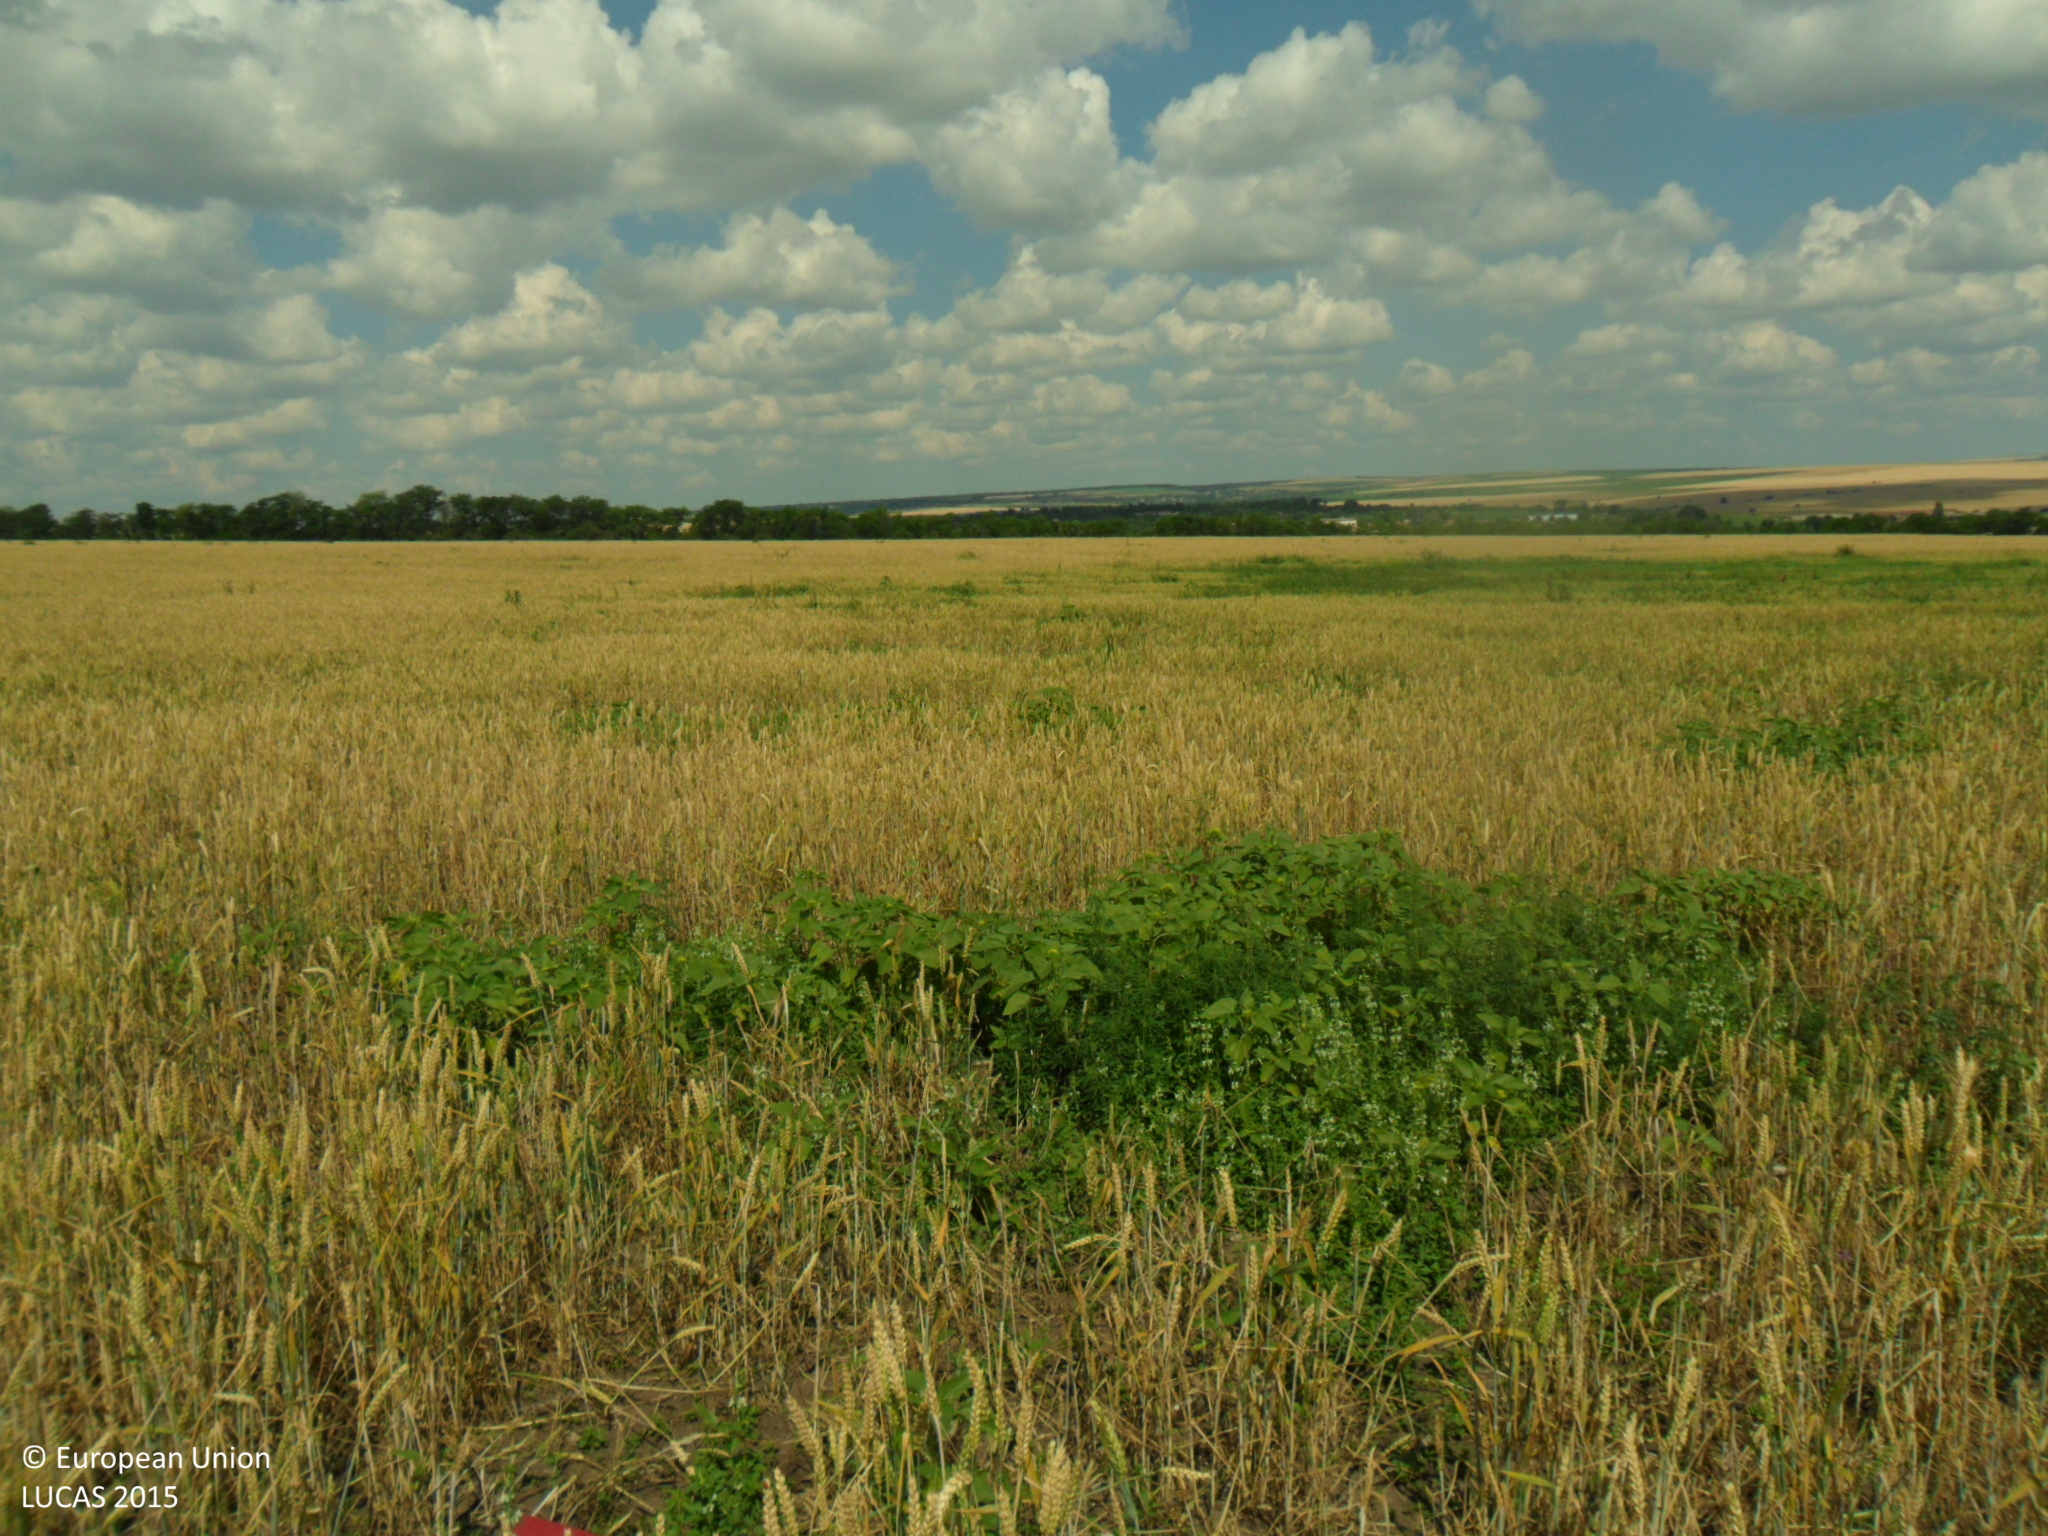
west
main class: Cropland
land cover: Common wheat
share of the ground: > 75 %
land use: Agriculture (excluding fallow land and kitchen gardens)
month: June
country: BG
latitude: 43.3573
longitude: 27.0072
